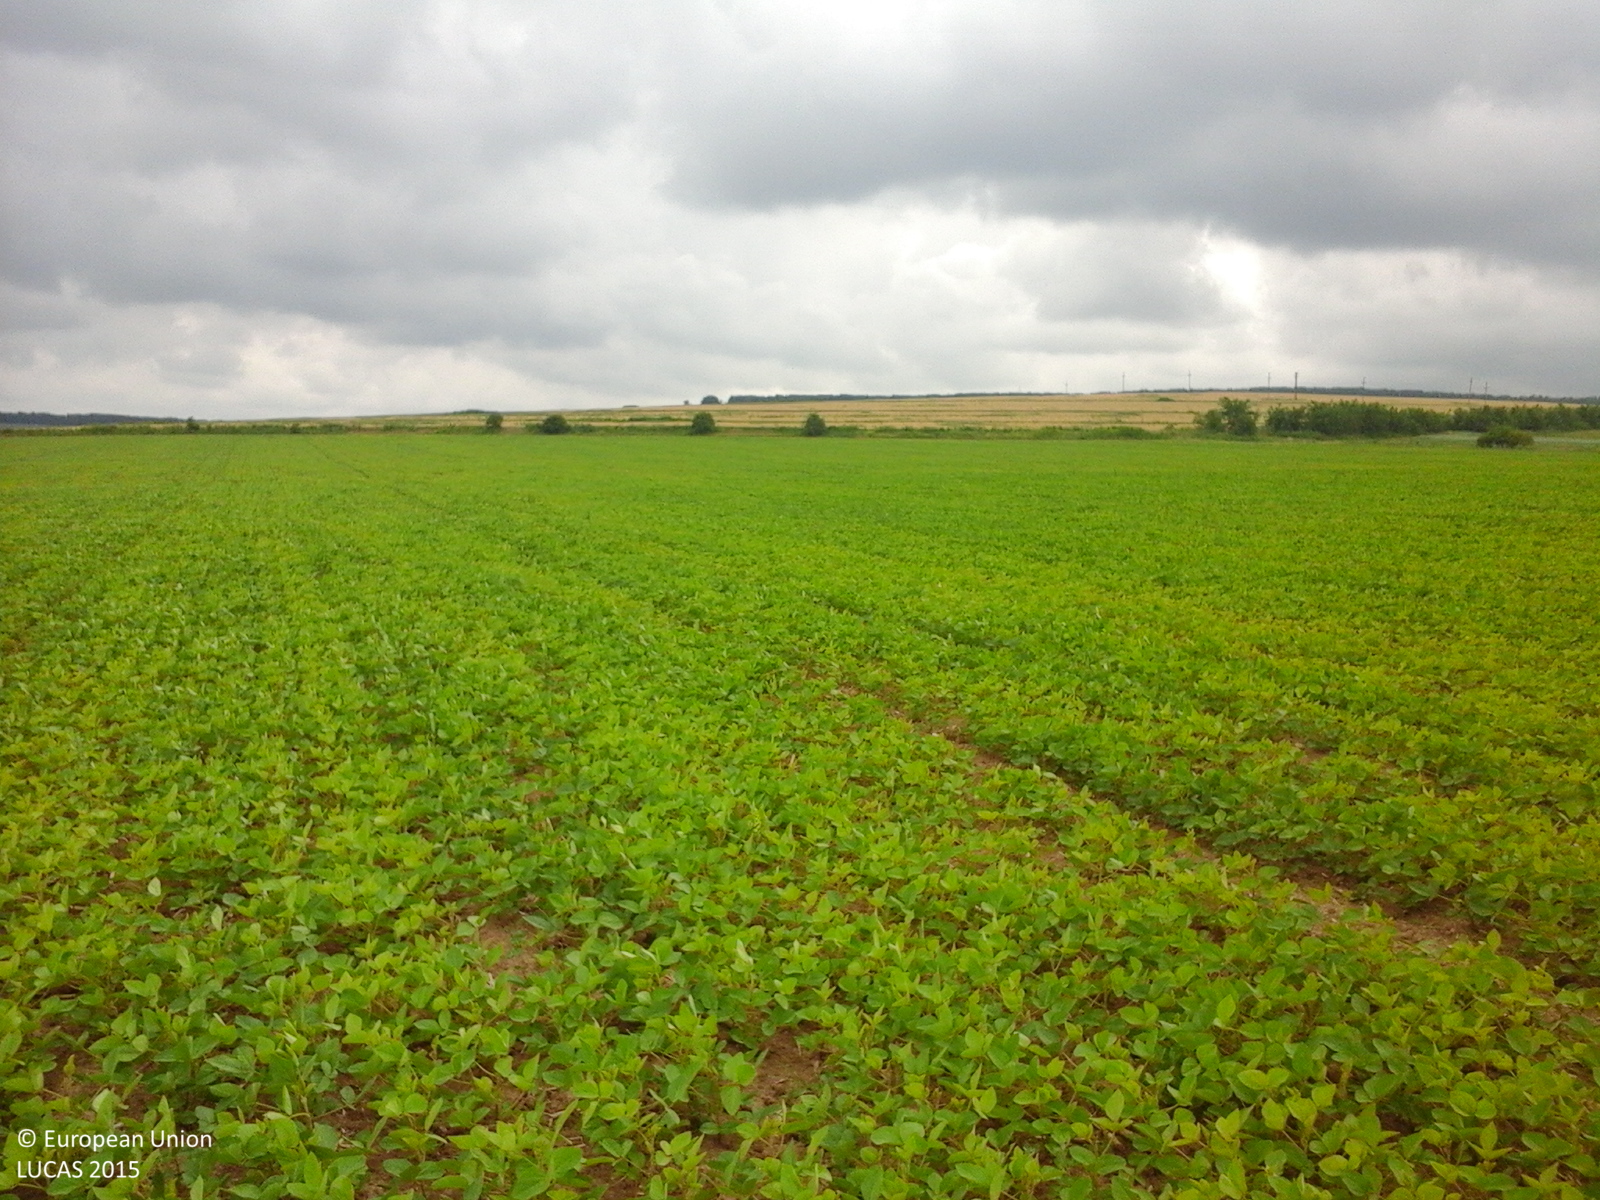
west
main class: Cropland
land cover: Soya
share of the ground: > 75 %
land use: Agriculture (excluding fallow land and kitchen gardens)
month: June
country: RO
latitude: 47.2363
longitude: 26.6696
